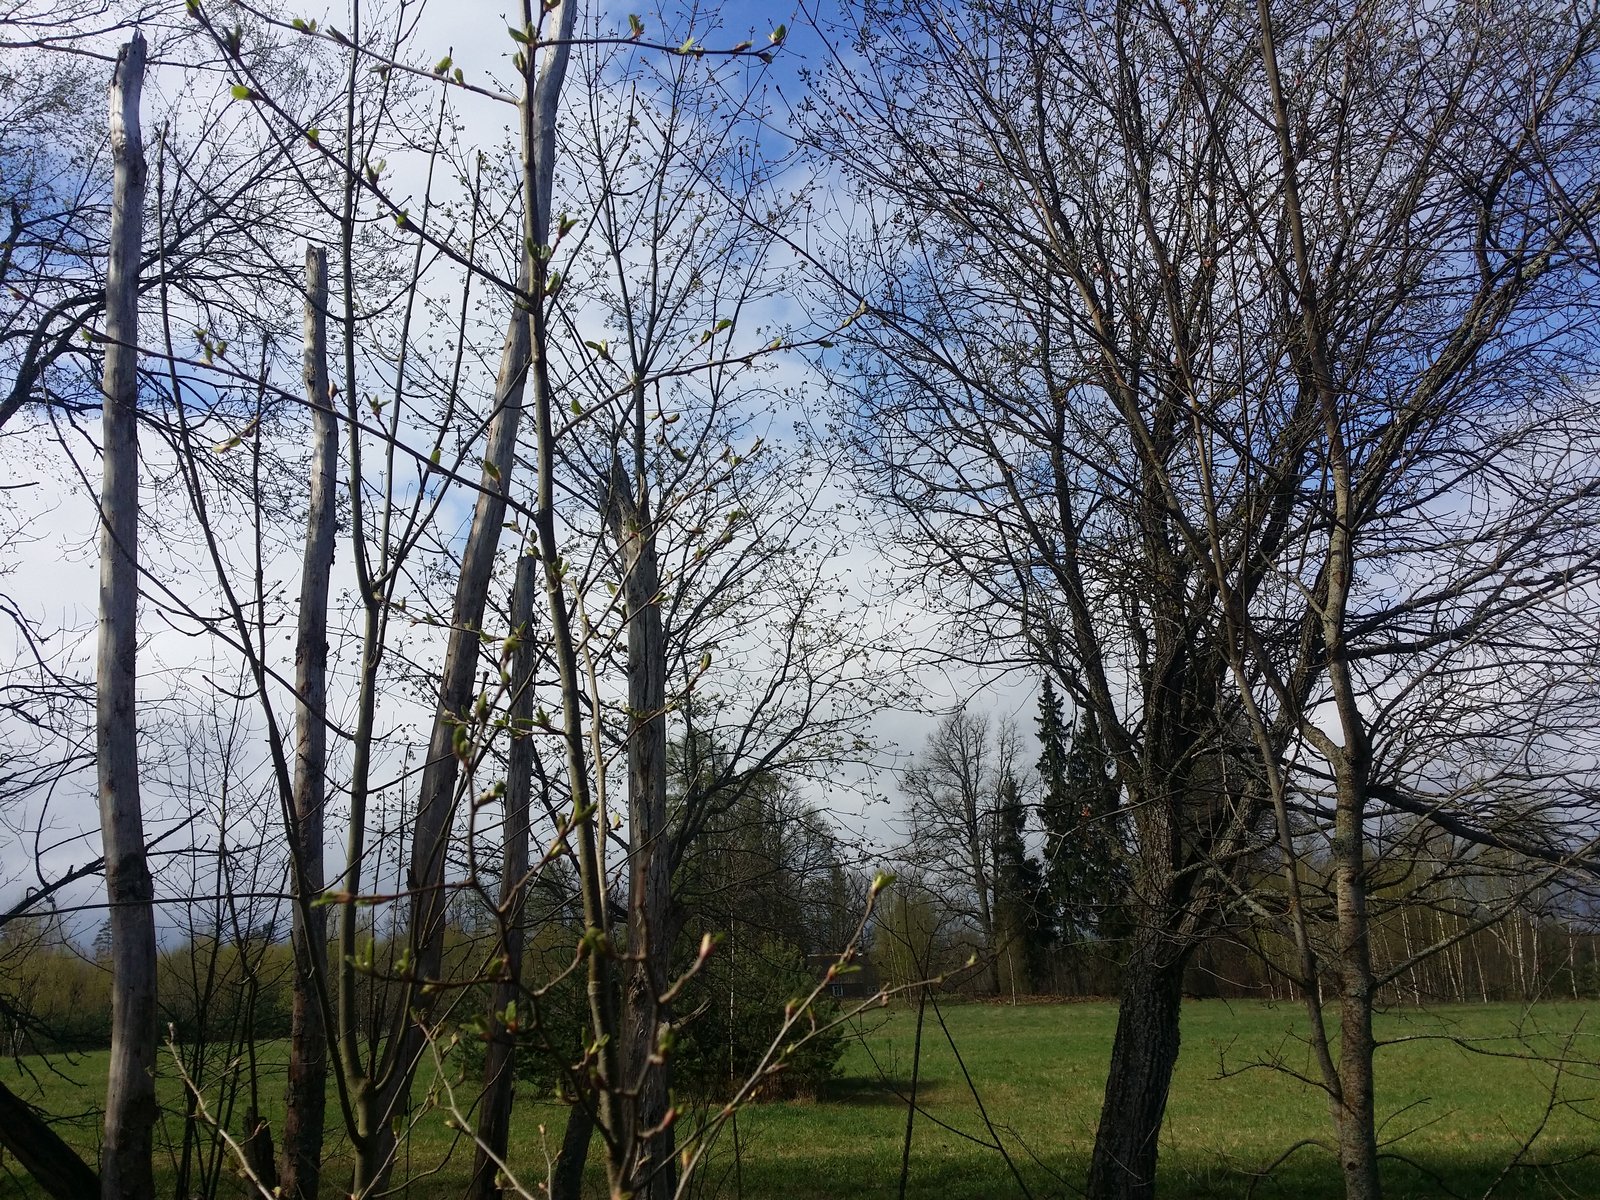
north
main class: Woodland
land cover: Broadleaved woodland
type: non-riverine alder, birch or aspen forest
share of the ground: 50 - 75 %
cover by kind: broadleaved forest trees 70 %, herbaceous plants 30 %
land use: Forestry
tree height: < 5 m
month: May
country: LV
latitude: 57.3999
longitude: 25.9881
